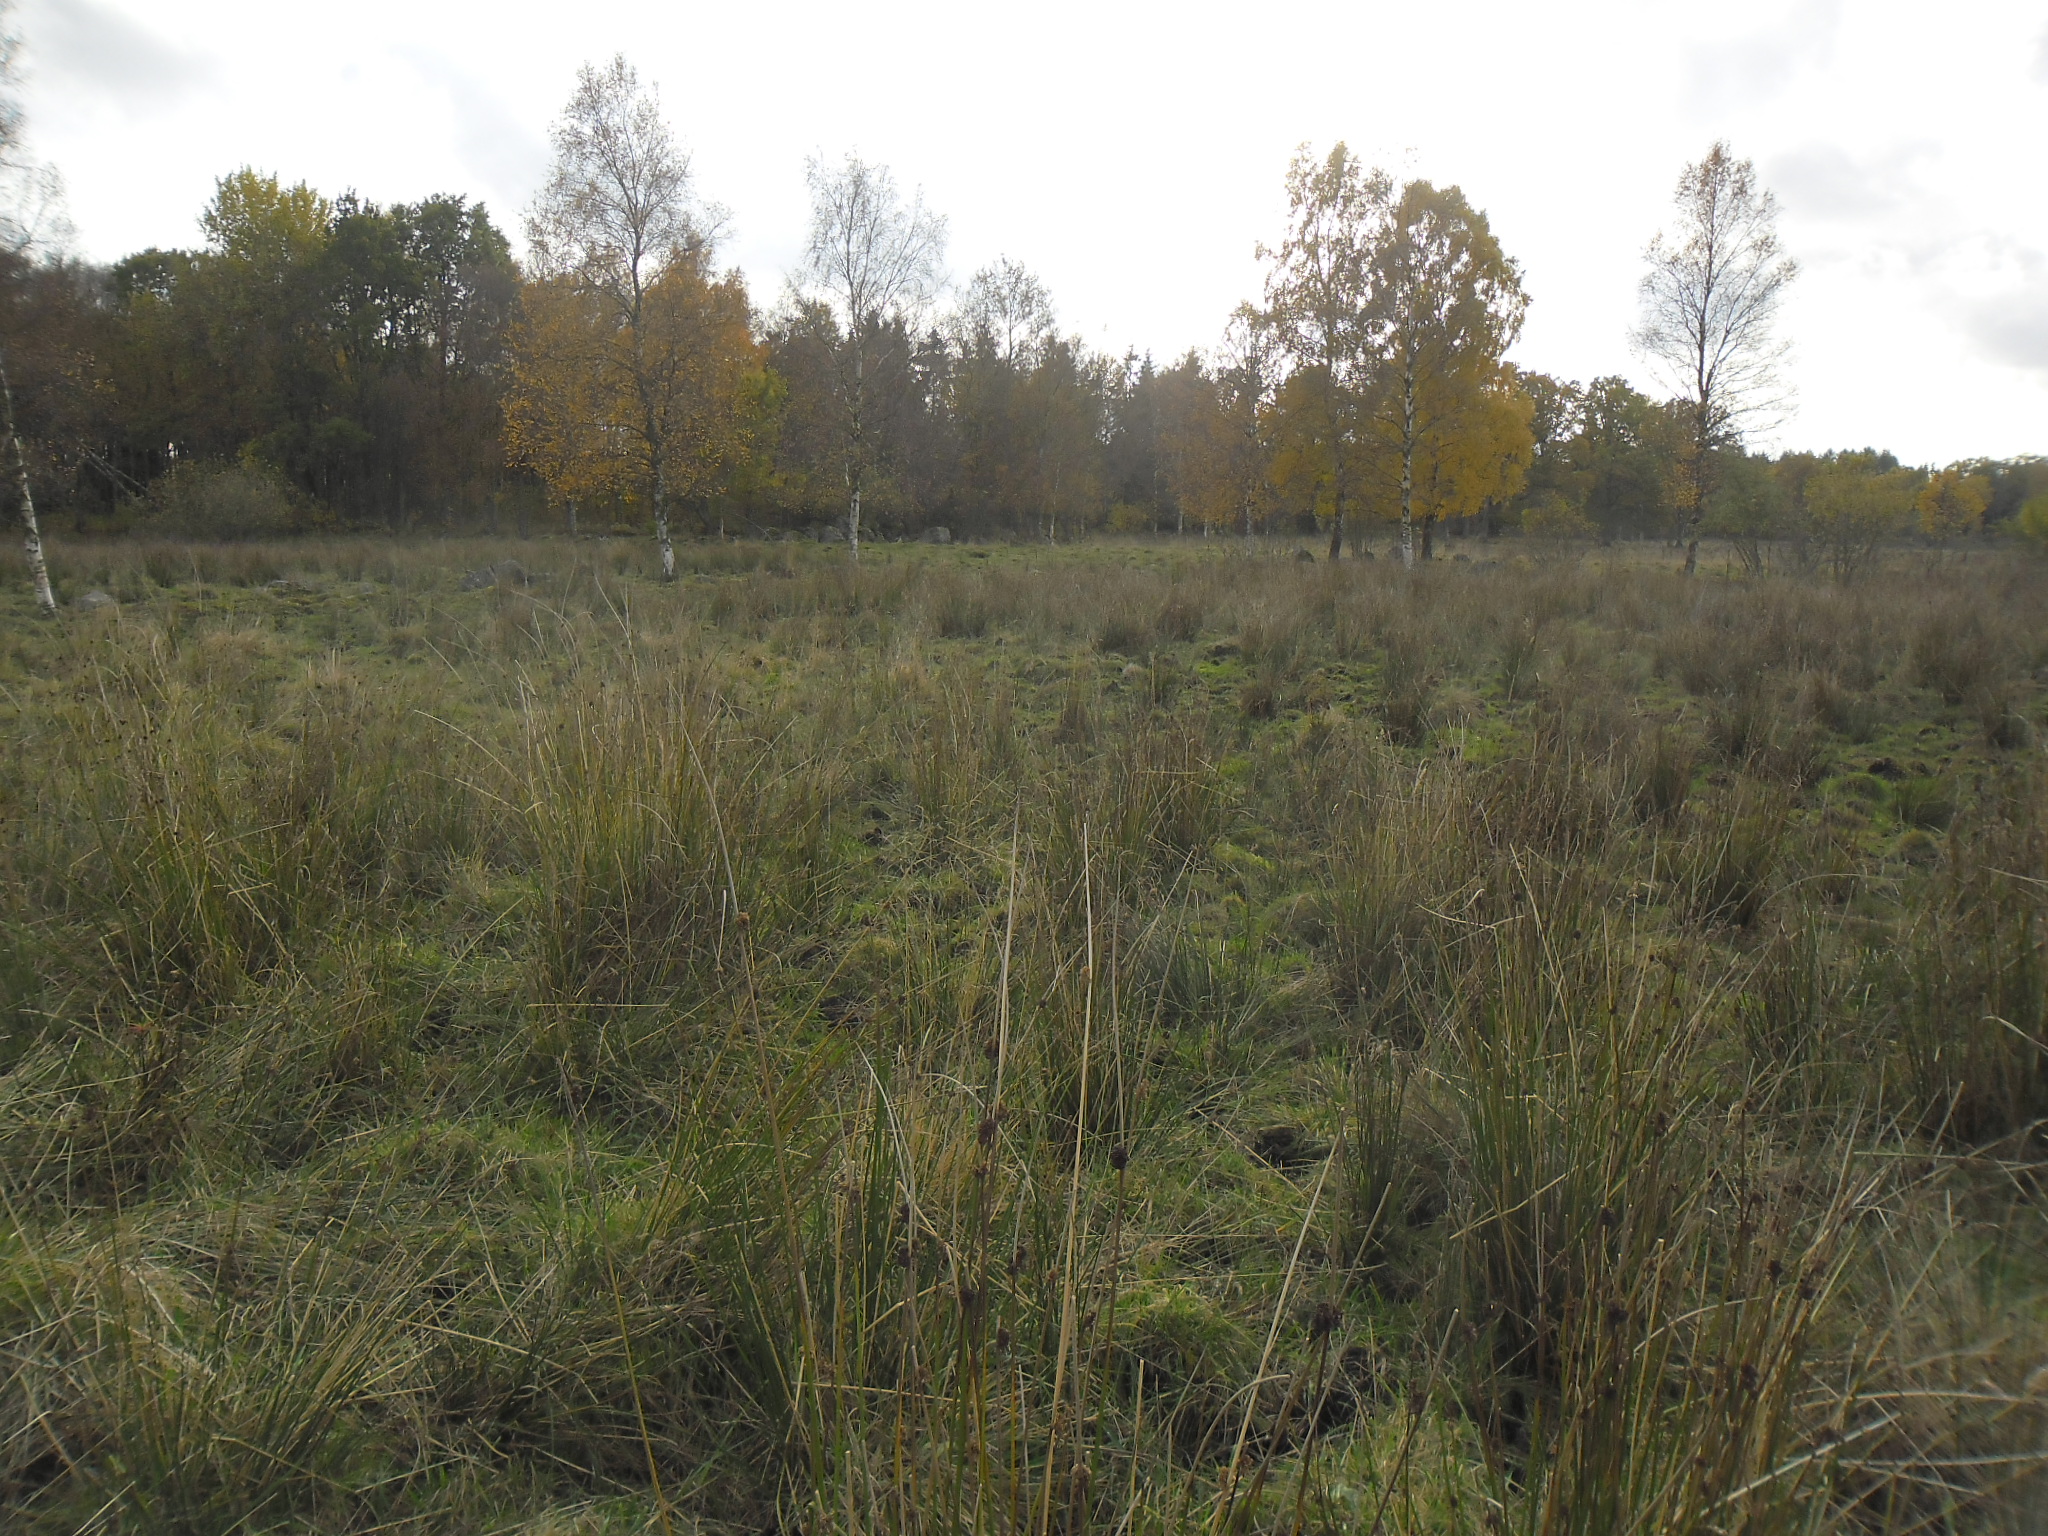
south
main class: Grassland
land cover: Grassland without tree/shrub cover
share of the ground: > 75 %
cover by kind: herbaceous plants 100 %
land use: Agriculture (excluding fallow land and kitchen gardens)
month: October
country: SE
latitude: 56.0254
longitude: 13.7362
